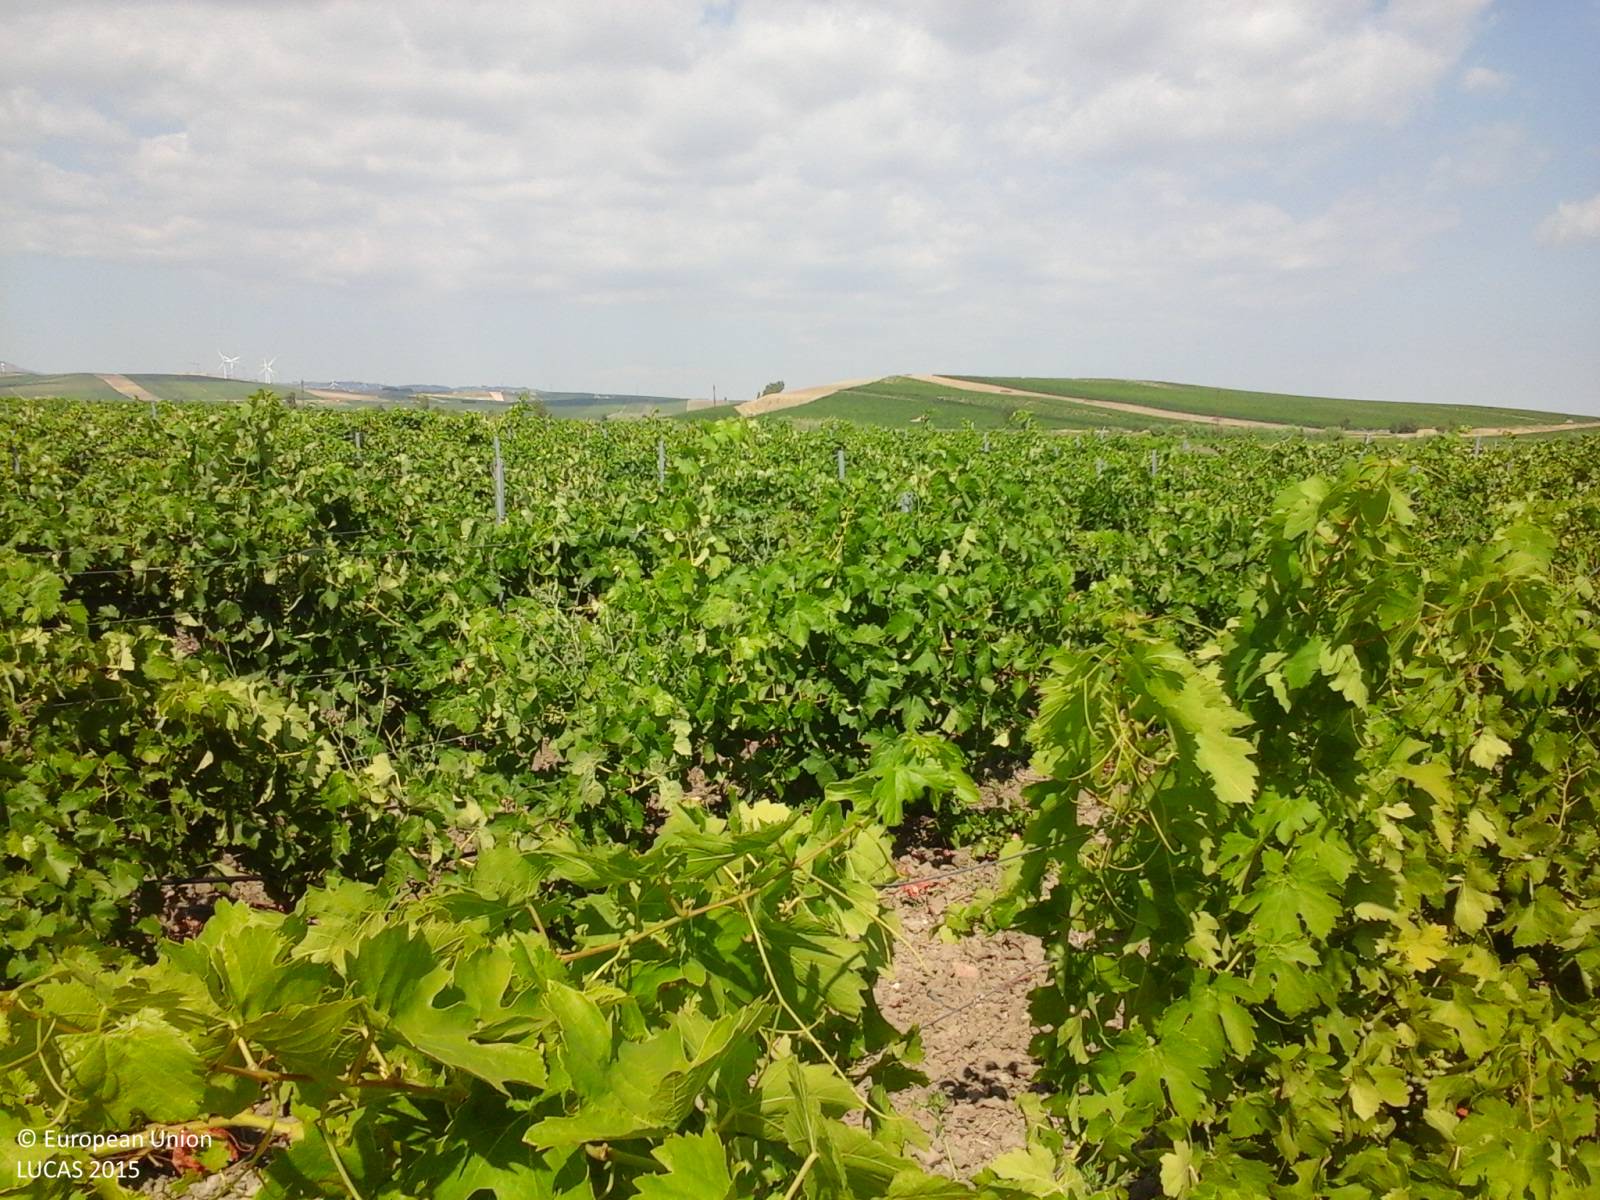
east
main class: Cropland
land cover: Vineyards
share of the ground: 50 - 75 %
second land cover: Other bare soil
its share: > 75 %
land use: Agriculture (excluding fallow land and kitchen gardens)
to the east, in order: Vineyards; Other bare soil; Tracks; Spontaneously vegetated surfaces; Vineyards; Inland fresh running water; Vineyards
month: July
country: IT
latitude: 37.7833
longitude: 12.6485
